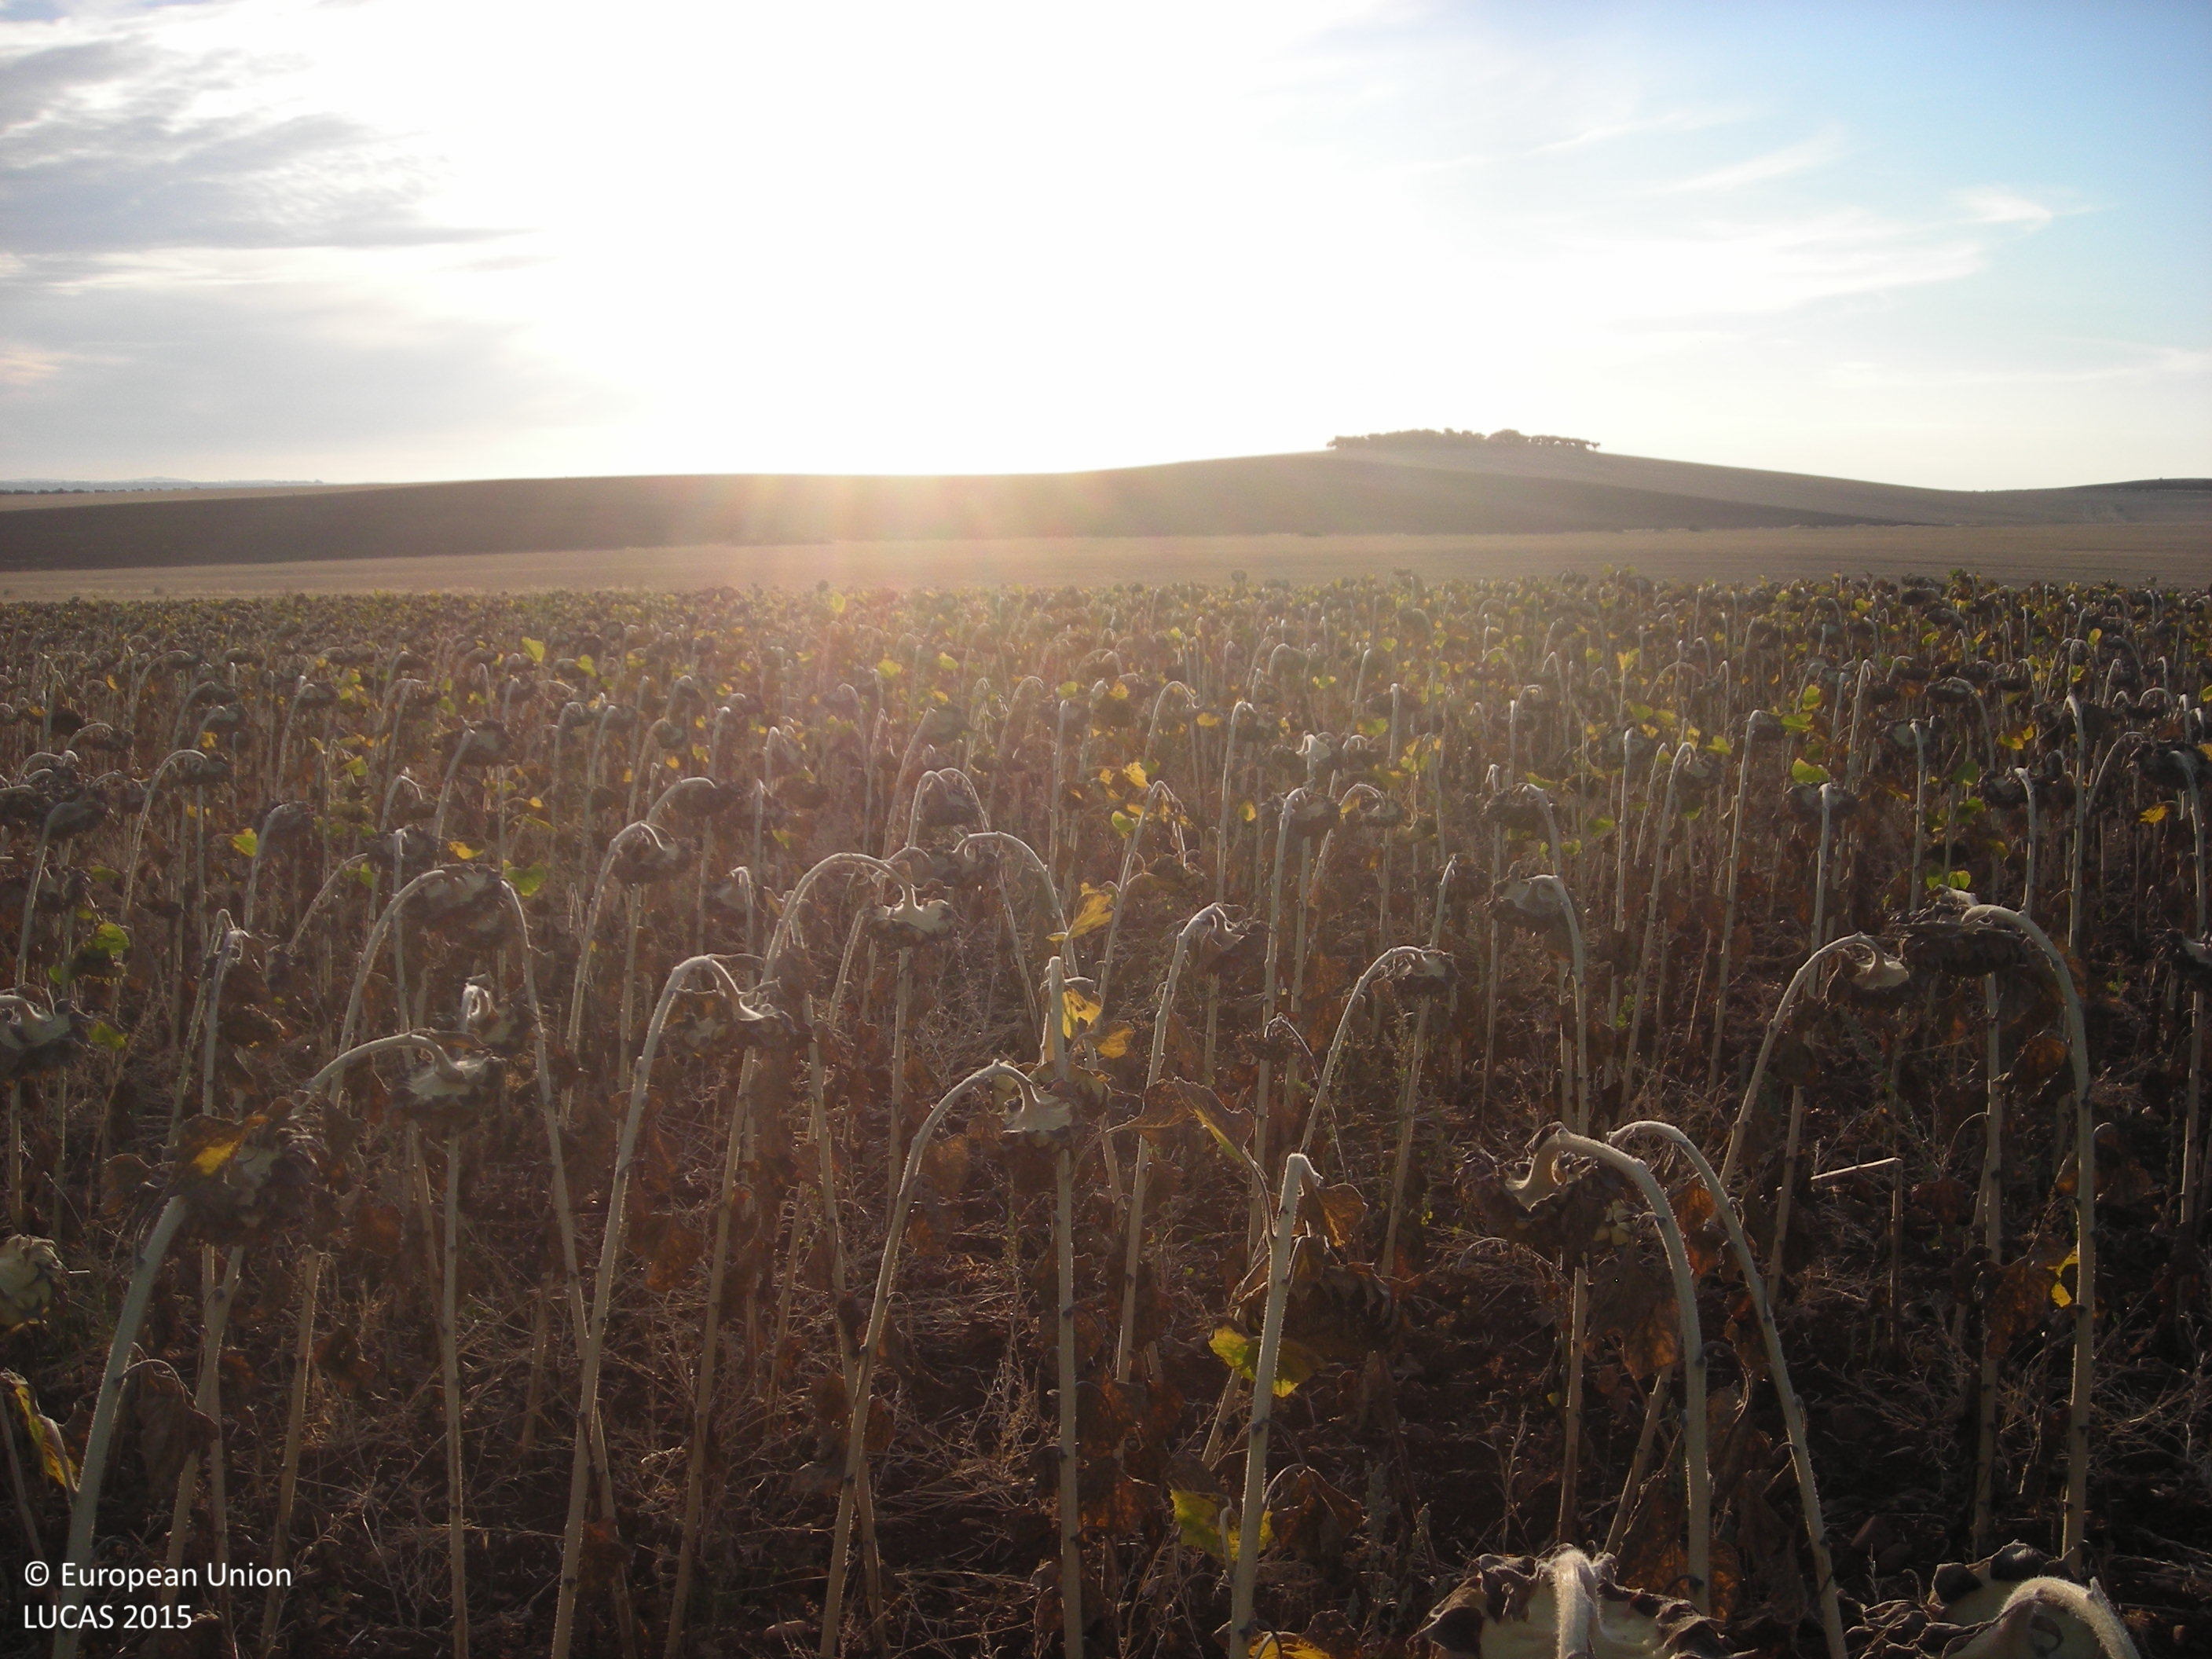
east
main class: Cropland
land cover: Sunflower
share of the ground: > 75 %
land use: Agriculture (excluding fallow land and kitchen gardens)
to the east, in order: Sunflower; Common wheat
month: July
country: ES
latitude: 38.8978
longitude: -5.9500
